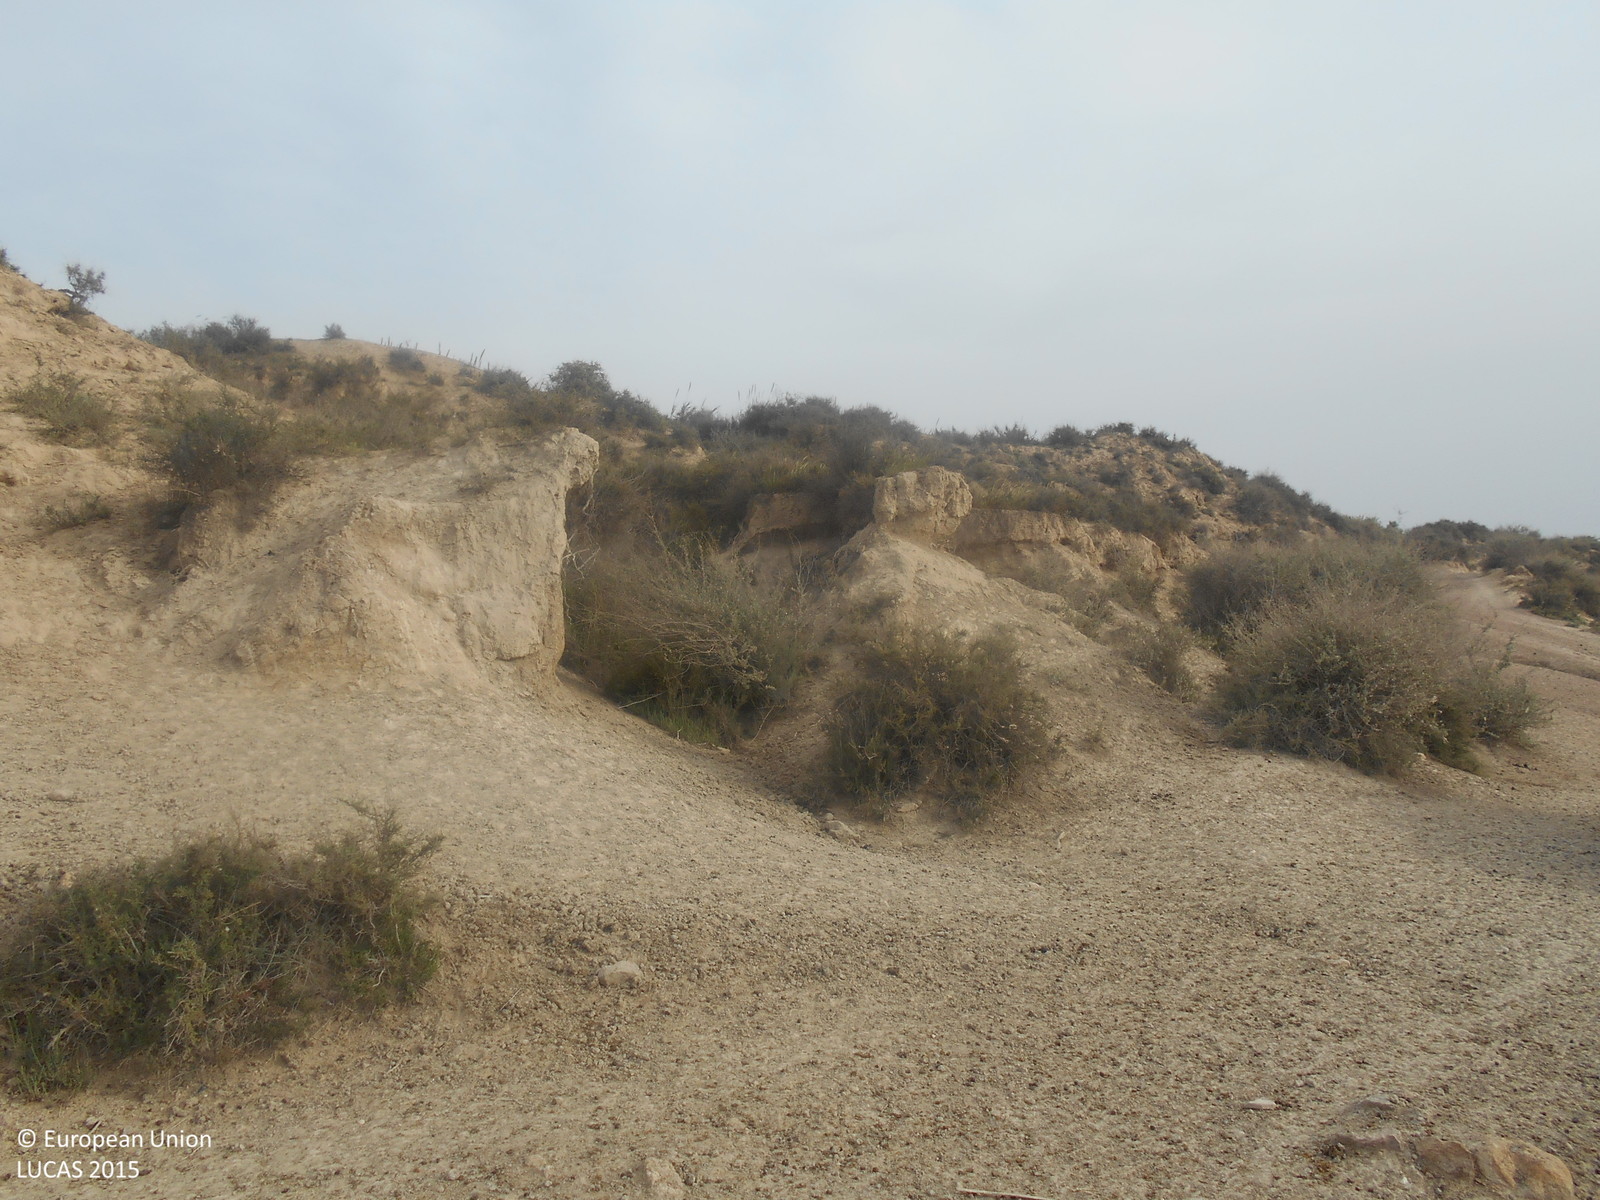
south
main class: Shrubland
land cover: Shrubland without tree cover
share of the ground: 25 - 50 %
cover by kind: shrubs 40 %, unconsolidated bare surface 40 %, herbaceous plants 20 %
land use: Semi-natural and natural areas not in use
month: April
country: ES
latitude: 37.7535
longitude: -1.4117
